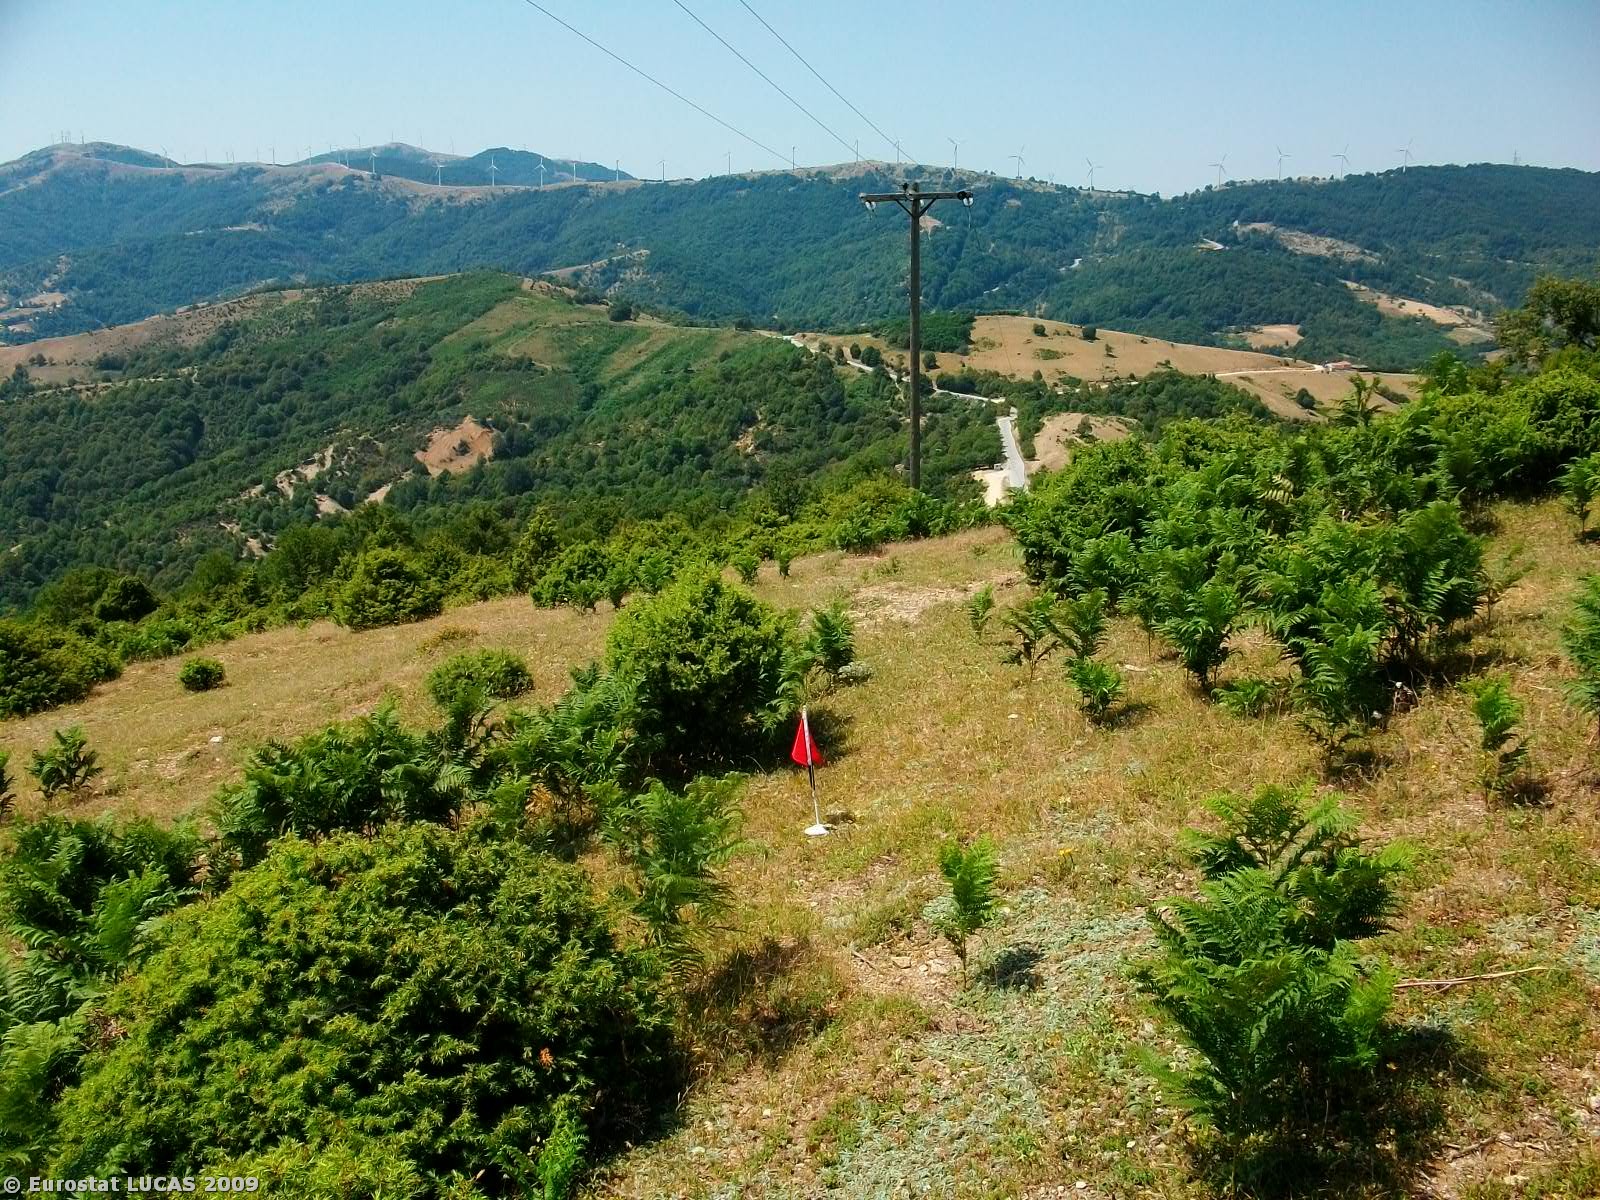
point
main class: Shrubland
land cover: Shrubland without tree cover
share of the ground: > 75 %
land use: Agriculture (excluding fallow land and kitchen gardens)
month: June
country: GR
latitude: 41.2108
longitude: 25.8636
